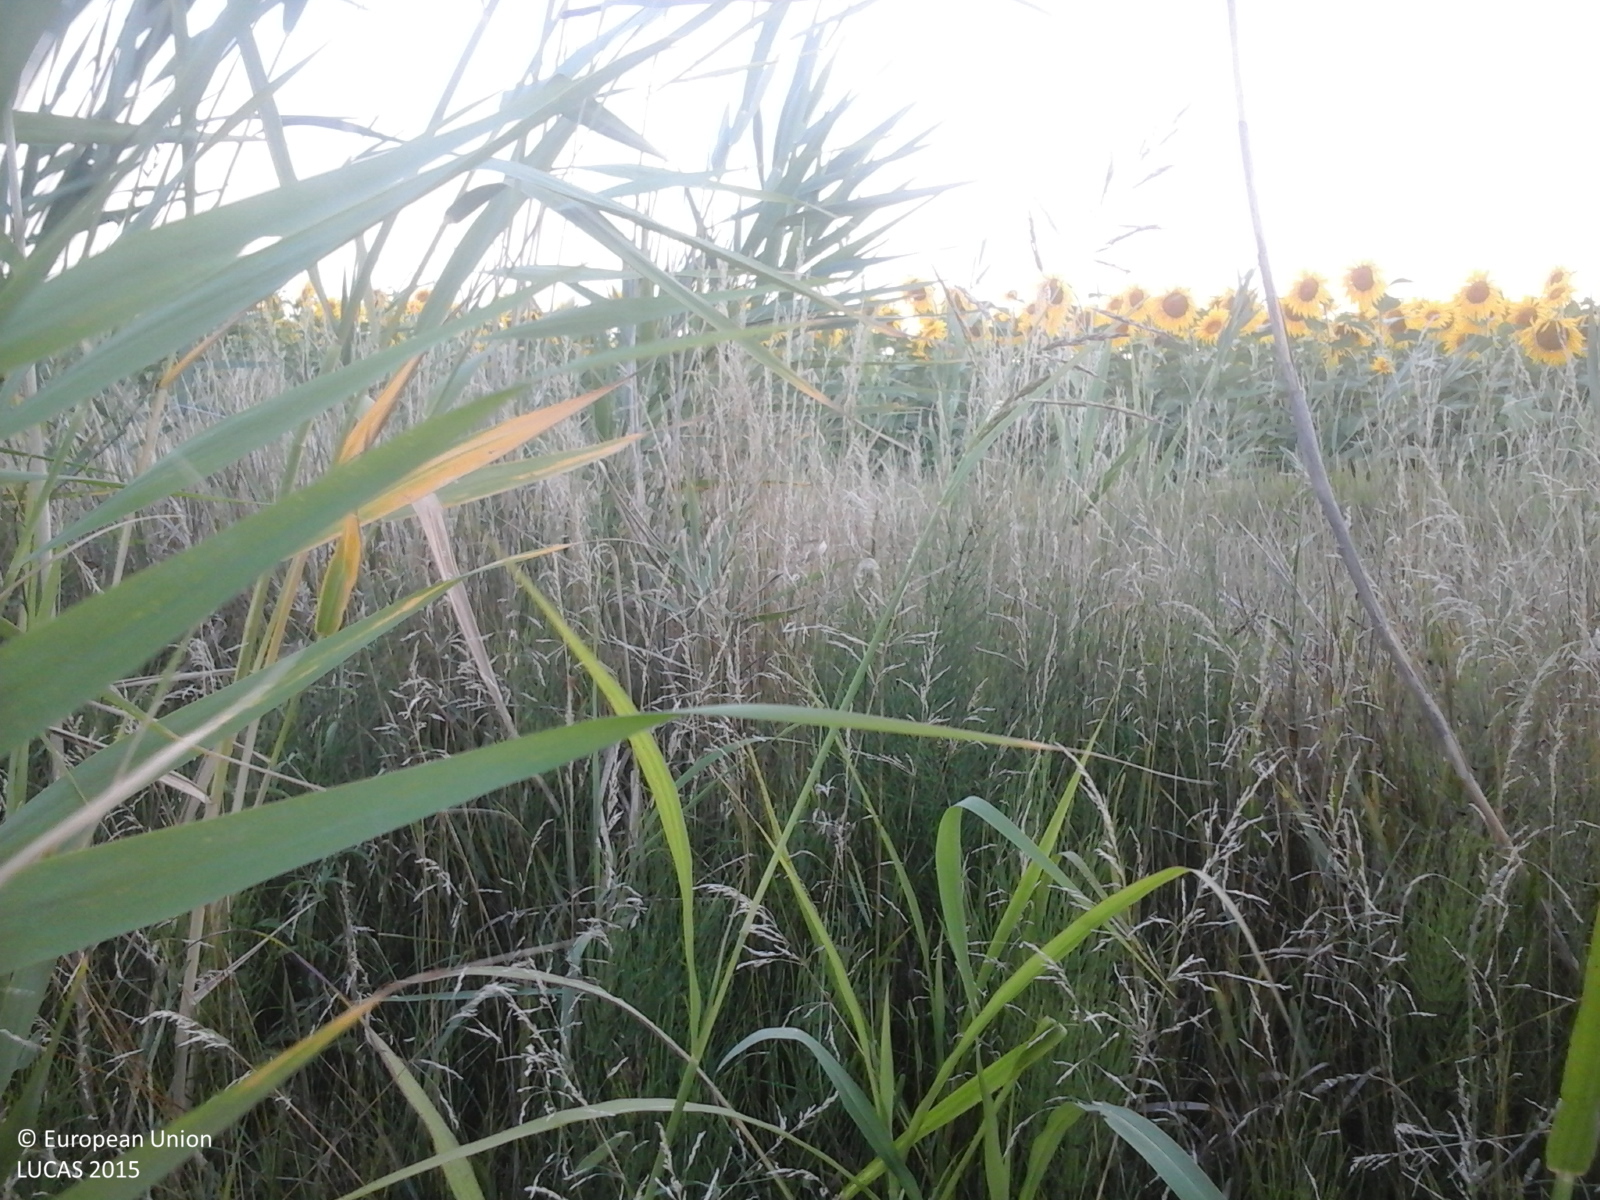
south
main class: Grassland
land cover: Spontaneously vegetated surfaces
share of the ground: 50 - 75 %
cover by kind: herbaceous plants 100 %
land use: Agriculture (excluding fallow land and kitchen gardens)
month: July
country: RO
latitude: 43.8484
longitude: 24.6847
